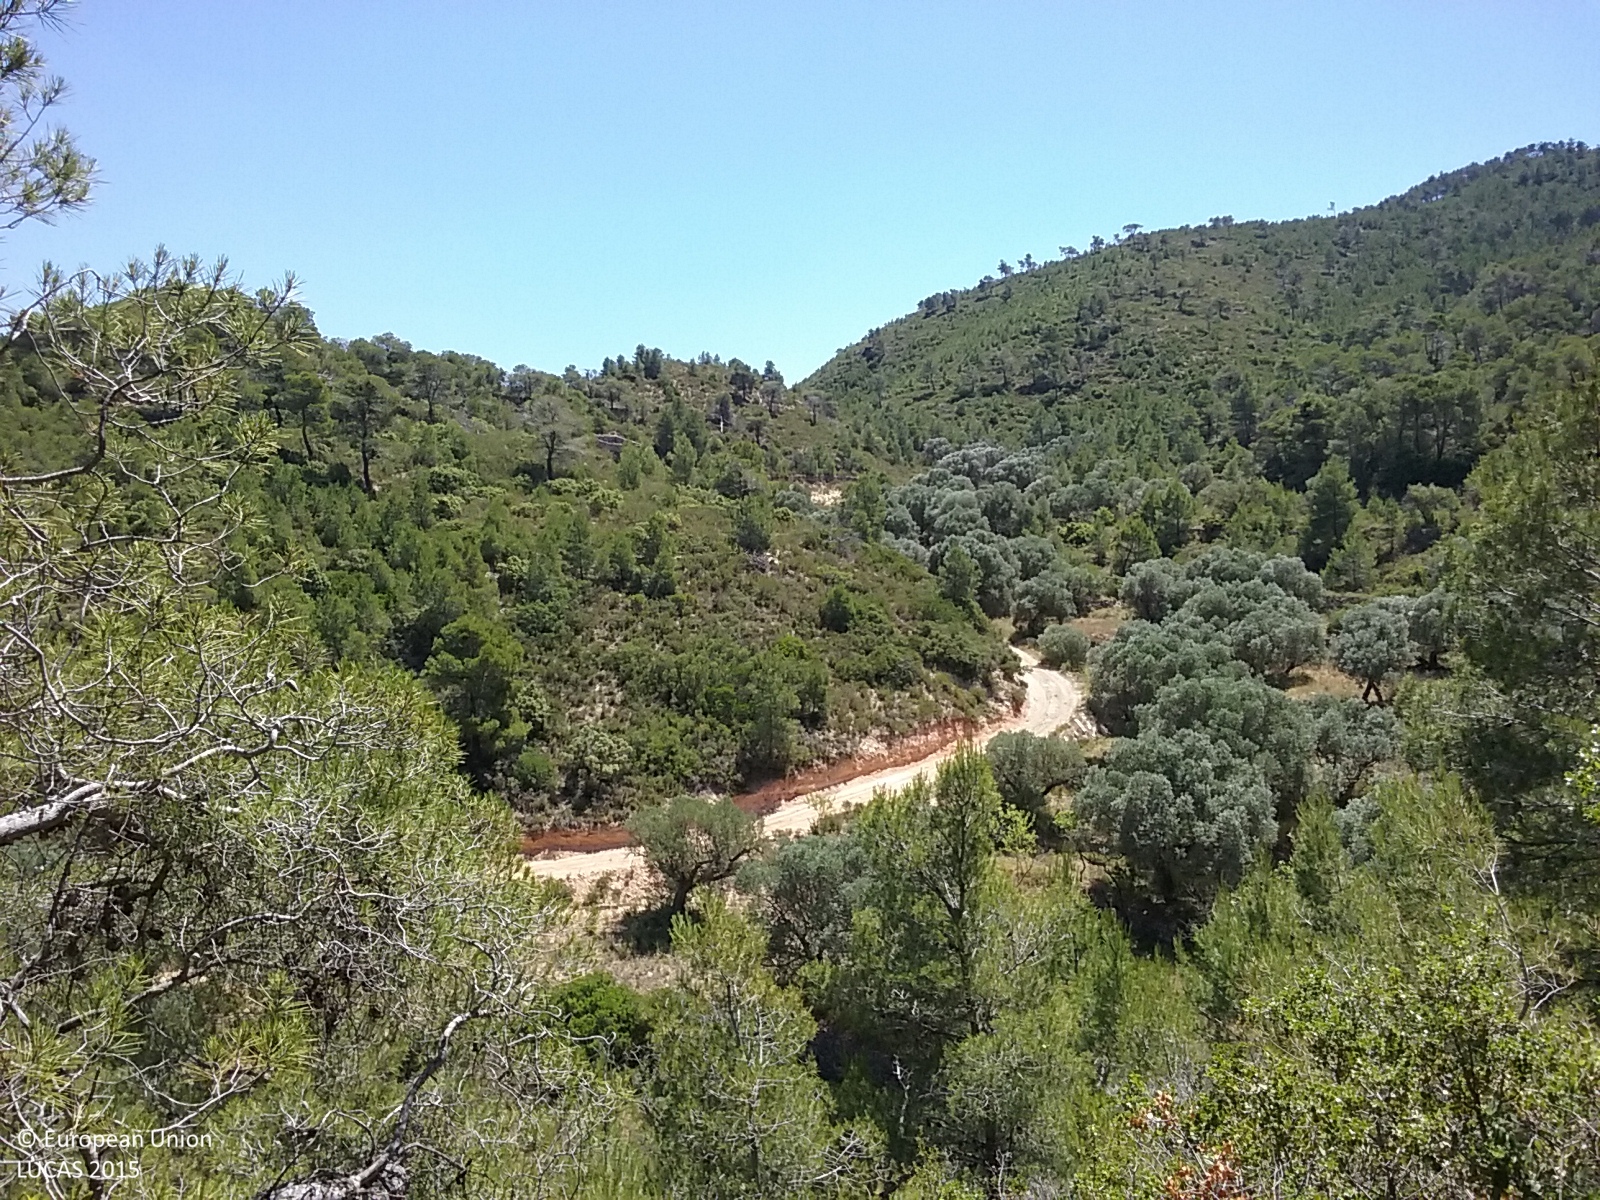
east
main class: Woodland
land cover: Pine dominated coniferous woodland
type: coniferous forest of the mediterranean region
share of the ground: > 75 %
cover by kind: coniferous forest trees 80 %, shrubs 20 %
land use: Semi-natural and natural areas not in use
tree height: > 5 m
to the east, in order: Pine dominated coniferous woodland; Dry stone walls; Pine dominated coniferous woodland; Dry stone walls; Pine dominated coniferous woodland; Groves; Dry stone walls; Nuts trees; Dry stone walls; Olive groves; Tracks; Pine dominated coniferous woodland; Dry stone walls; Pine dominated coniferous woodland; Shrubland with sparse tree cover; Groves; Shrubland with sparse tree cover; Olive groves; Dry stone walls; Shrubland with sparse tree cover; Artificial constructions in urban areas; Shrubland with sparse tree cover; Dry stone walls; Pine dominated coniferous woodland; Shrubland with sparse tree cover; Pine dominated coniferous woodland
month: June
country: ES
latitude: 41.2053
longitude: 0.4857
